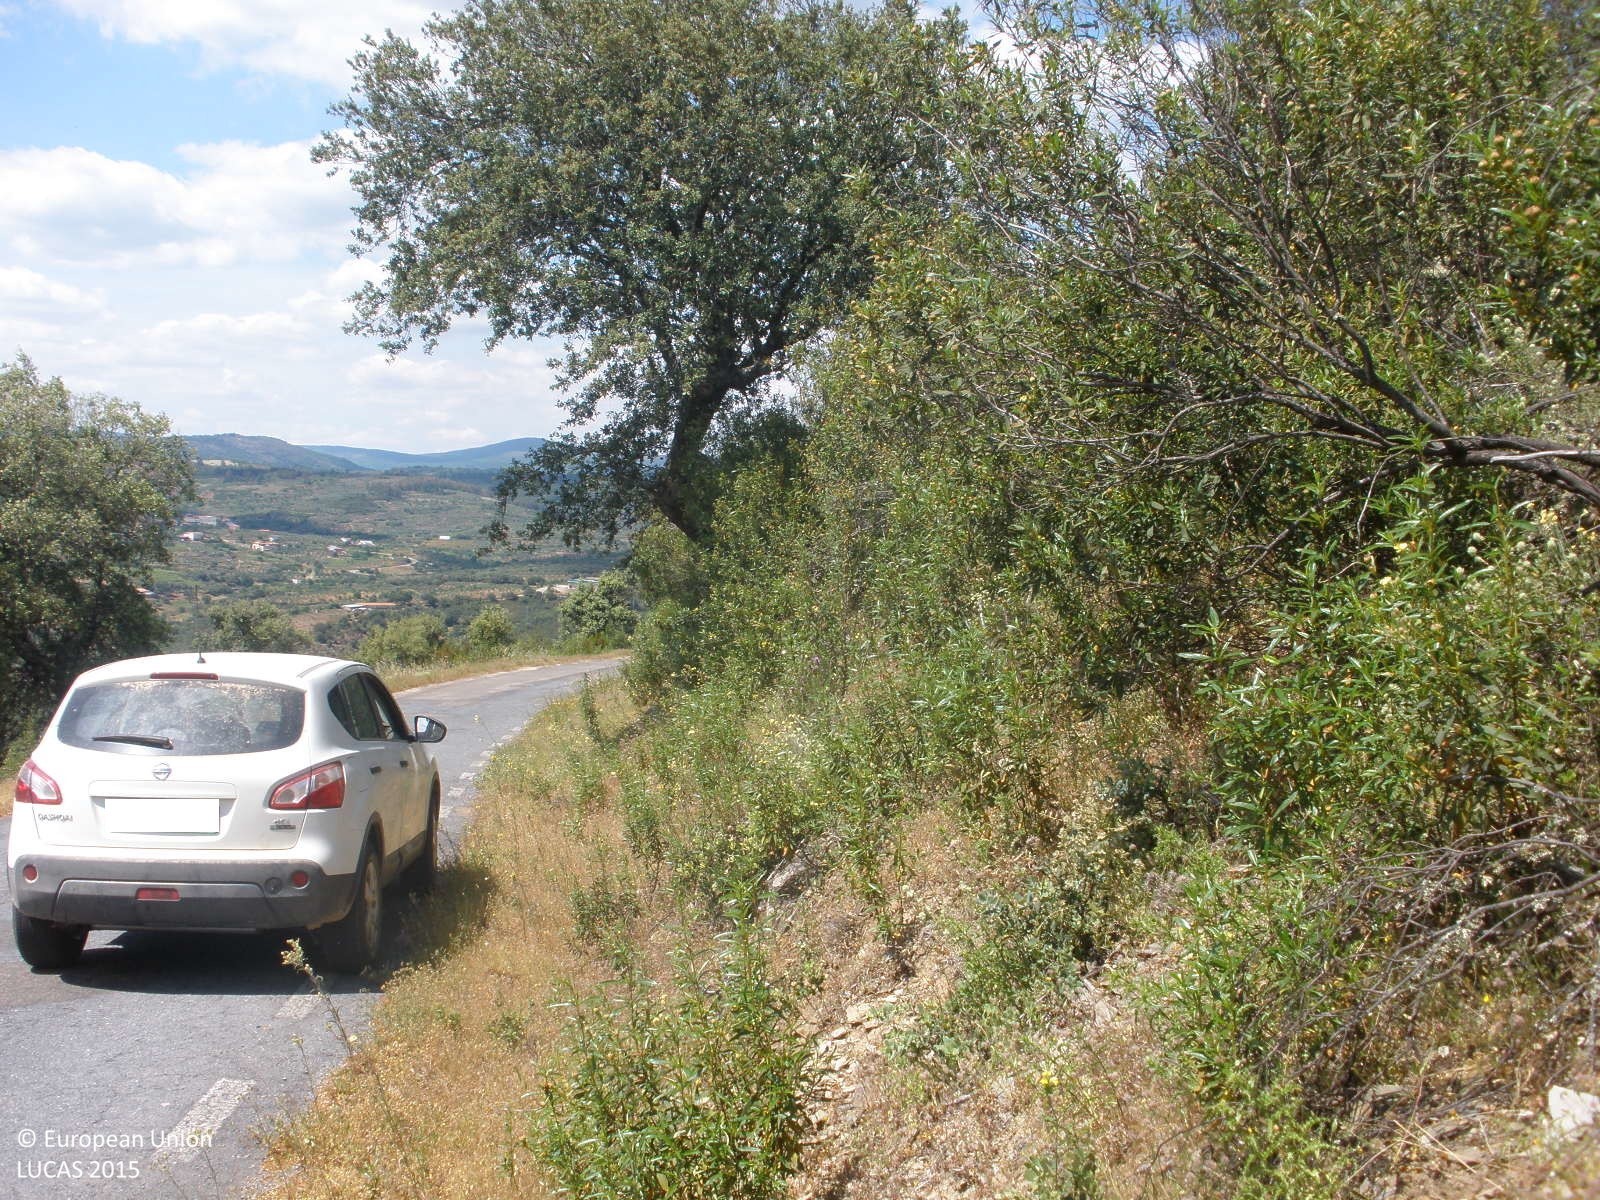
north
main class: Shrubland
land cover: Shrubland without tree cover
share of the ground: > 75 %
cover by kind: shrubs 80 %, herbaceous plants 20 %
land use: Semi-natural and natural areas not in use
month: May
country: ES
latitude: 40.4131
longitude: -6.0206
